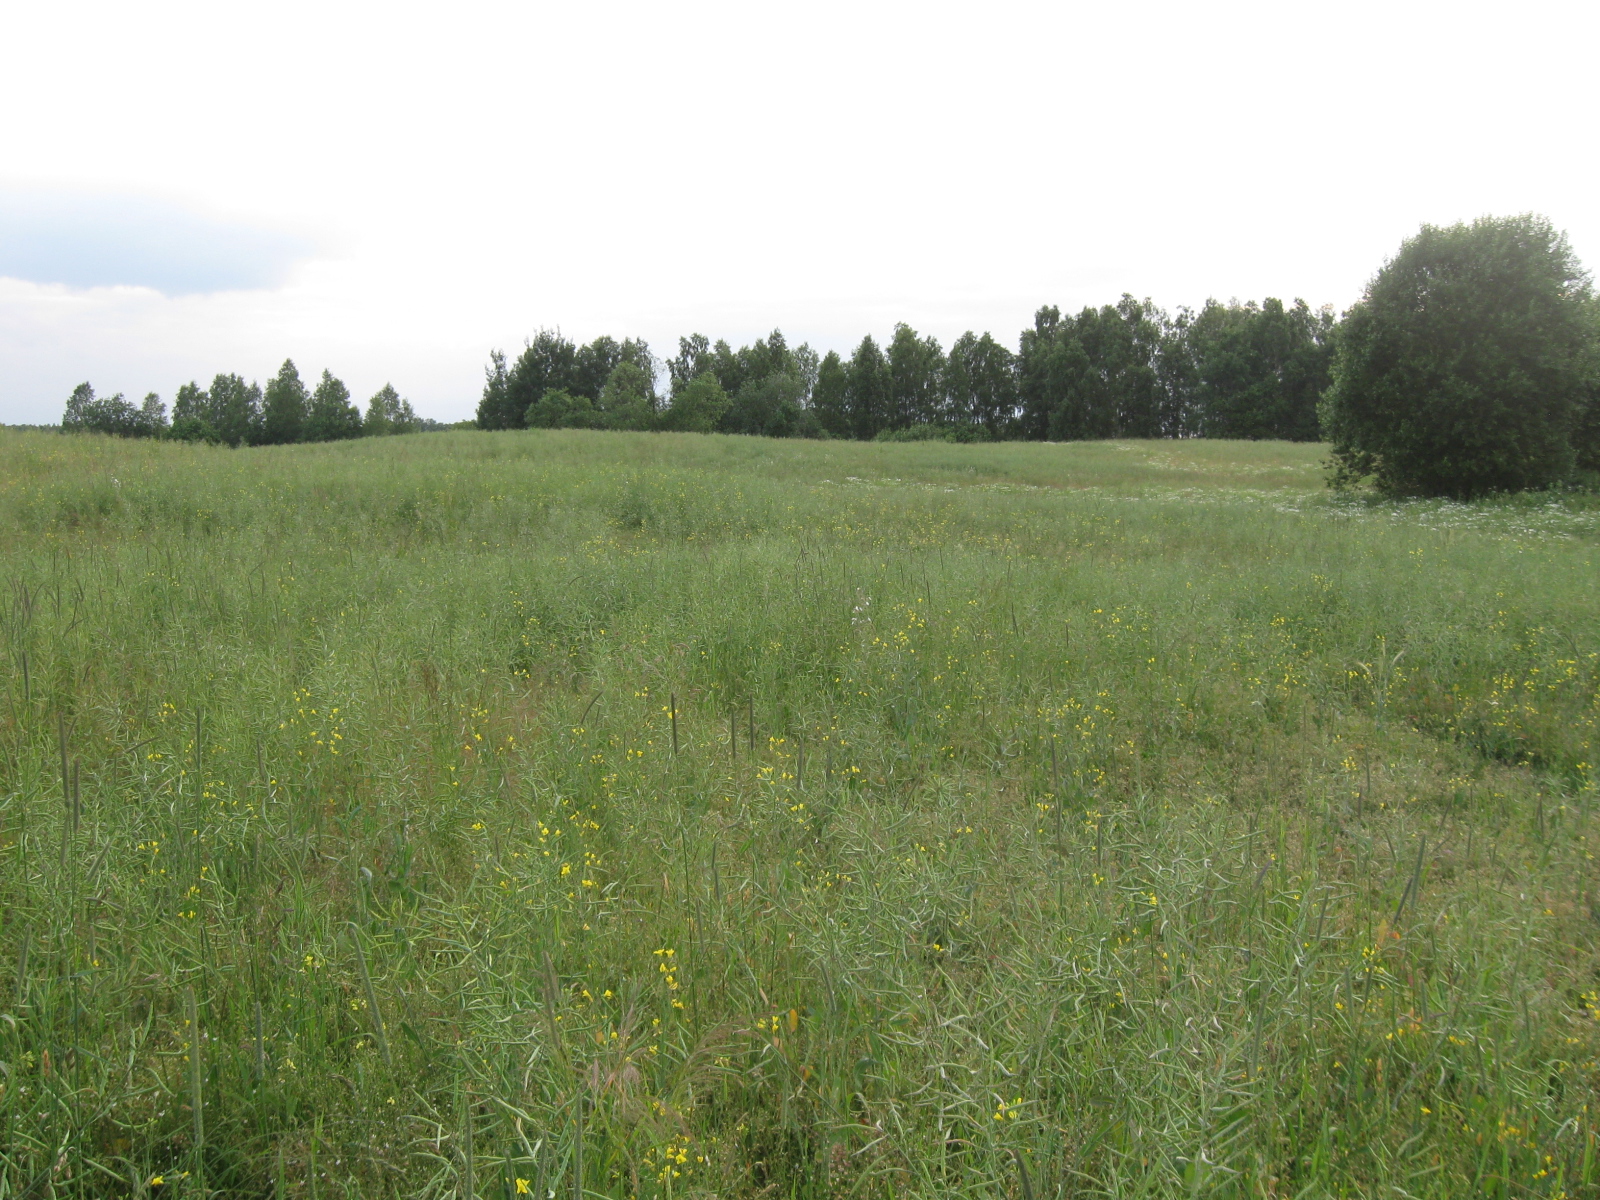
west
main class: Cropland
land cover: Rape and turnip rape
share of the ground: > 75 %
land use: Agriculture (excluding fallow land and kitchen gardens)
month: June
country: LT
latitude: 54.4123
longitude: 24.6049
